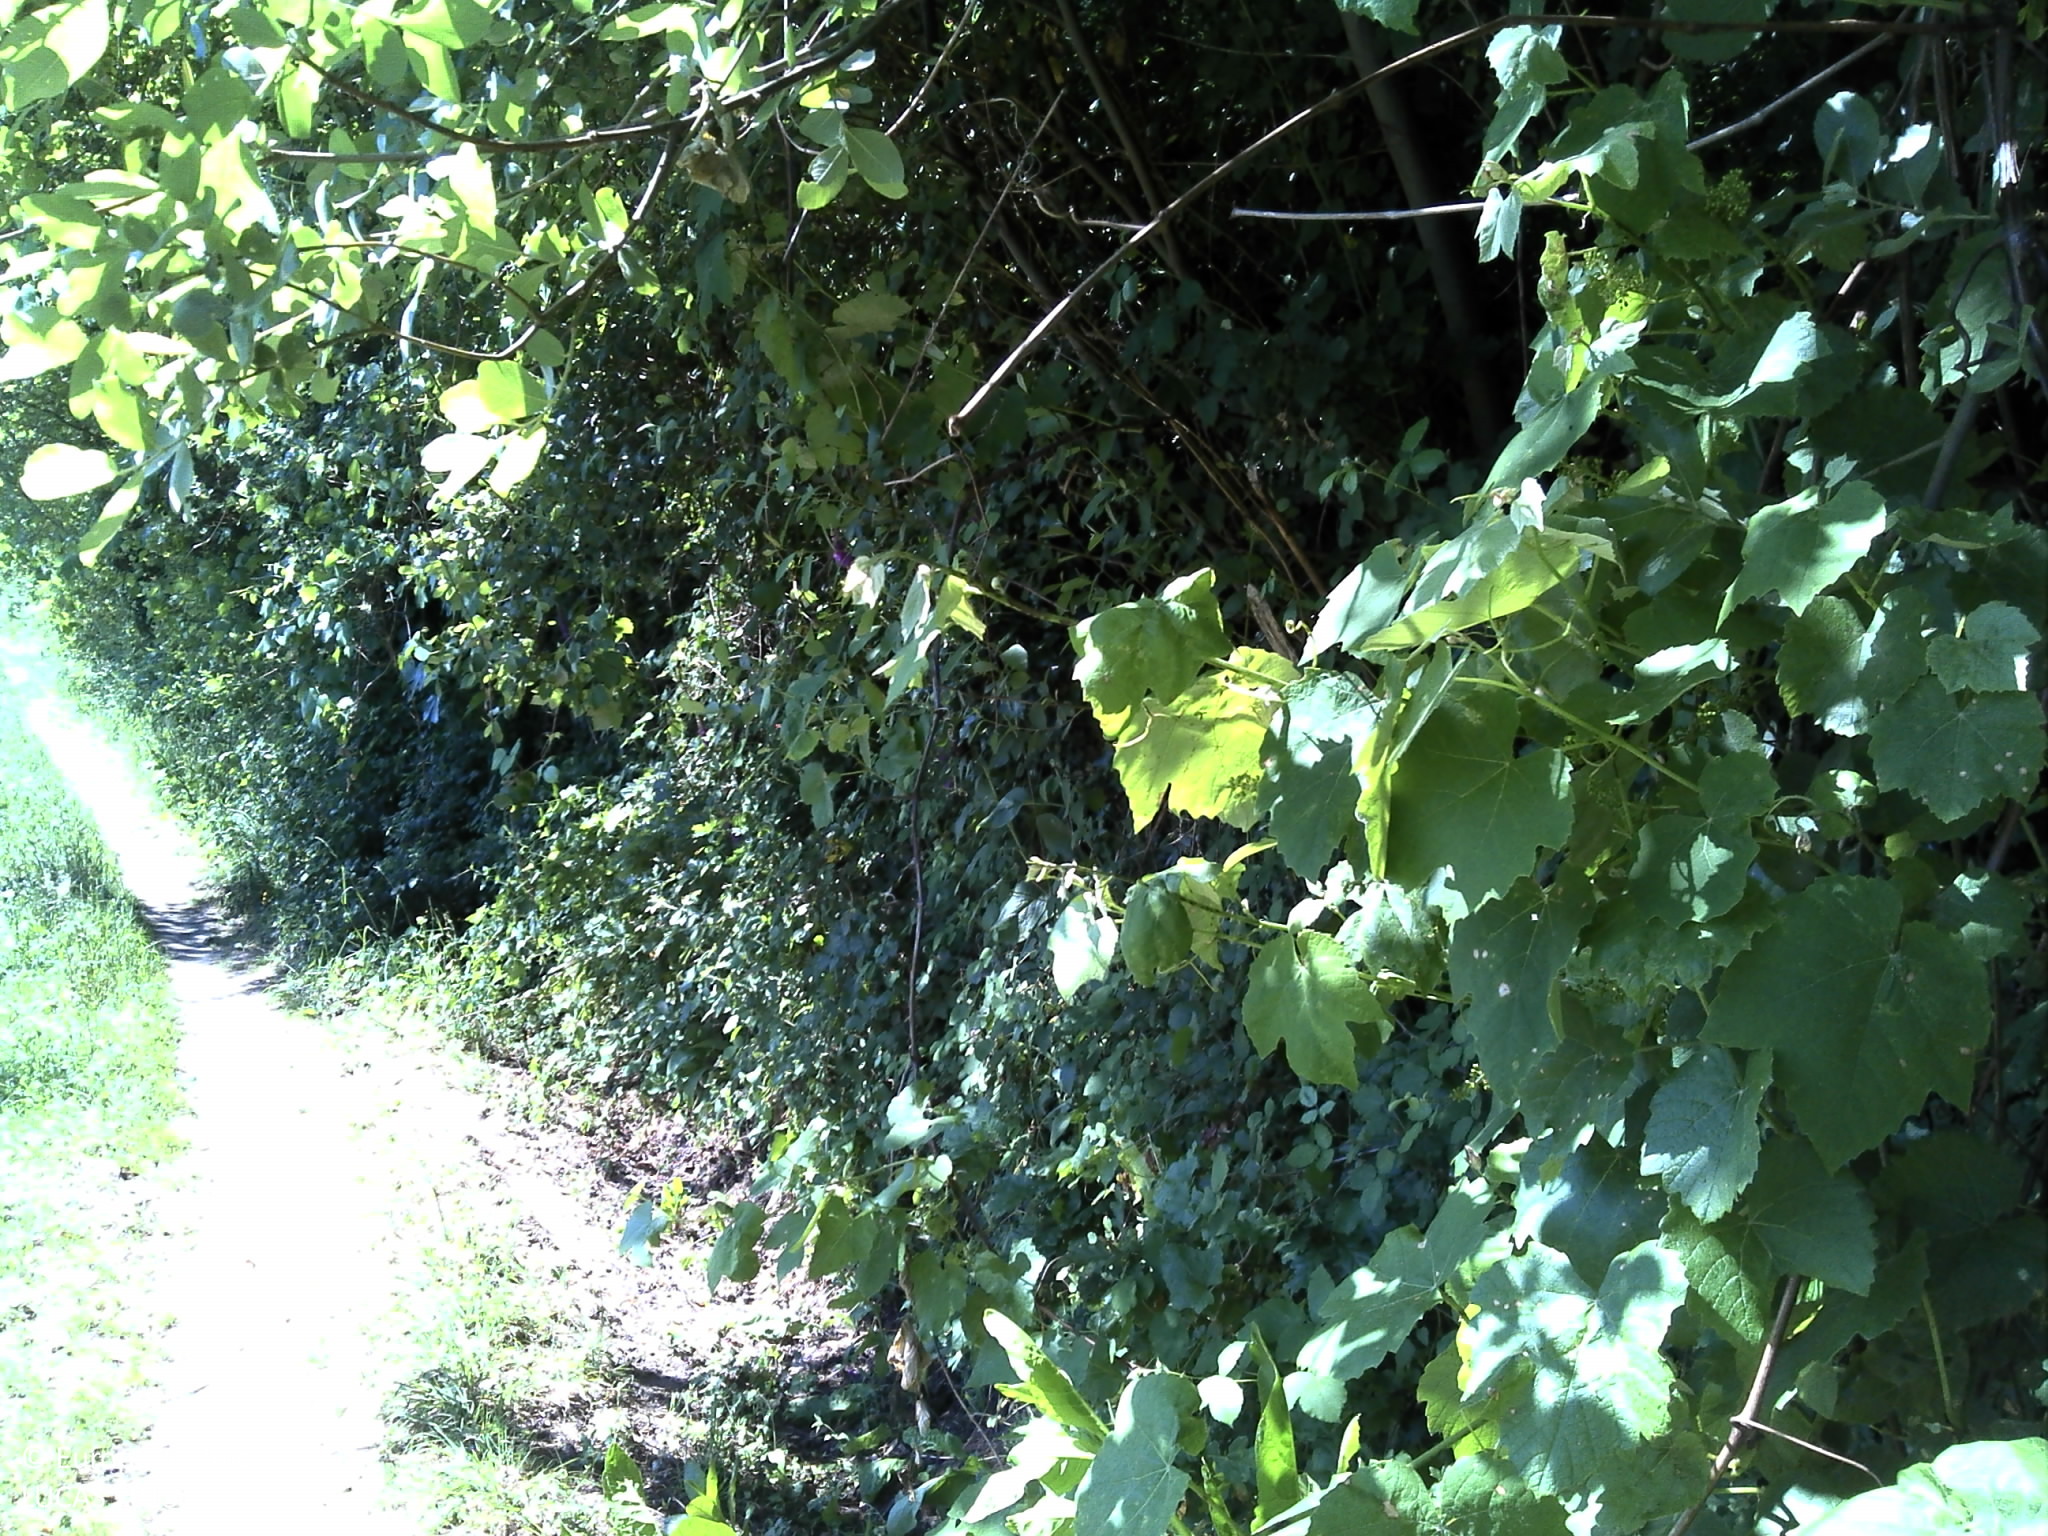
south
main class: Woodland
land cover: Broadleaved woodland
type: mesophytic deciduous forest
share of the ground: > 75 %
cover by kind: broadleaved forest trees 85 %, shrubs 5 %, herbaceous plants 5 %, unconsolidated bare surface 5 %
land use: Semi-natural and natural areas not in use
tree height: > 5 m
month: May
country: PT
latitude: 41.8982
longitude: -8.6692
